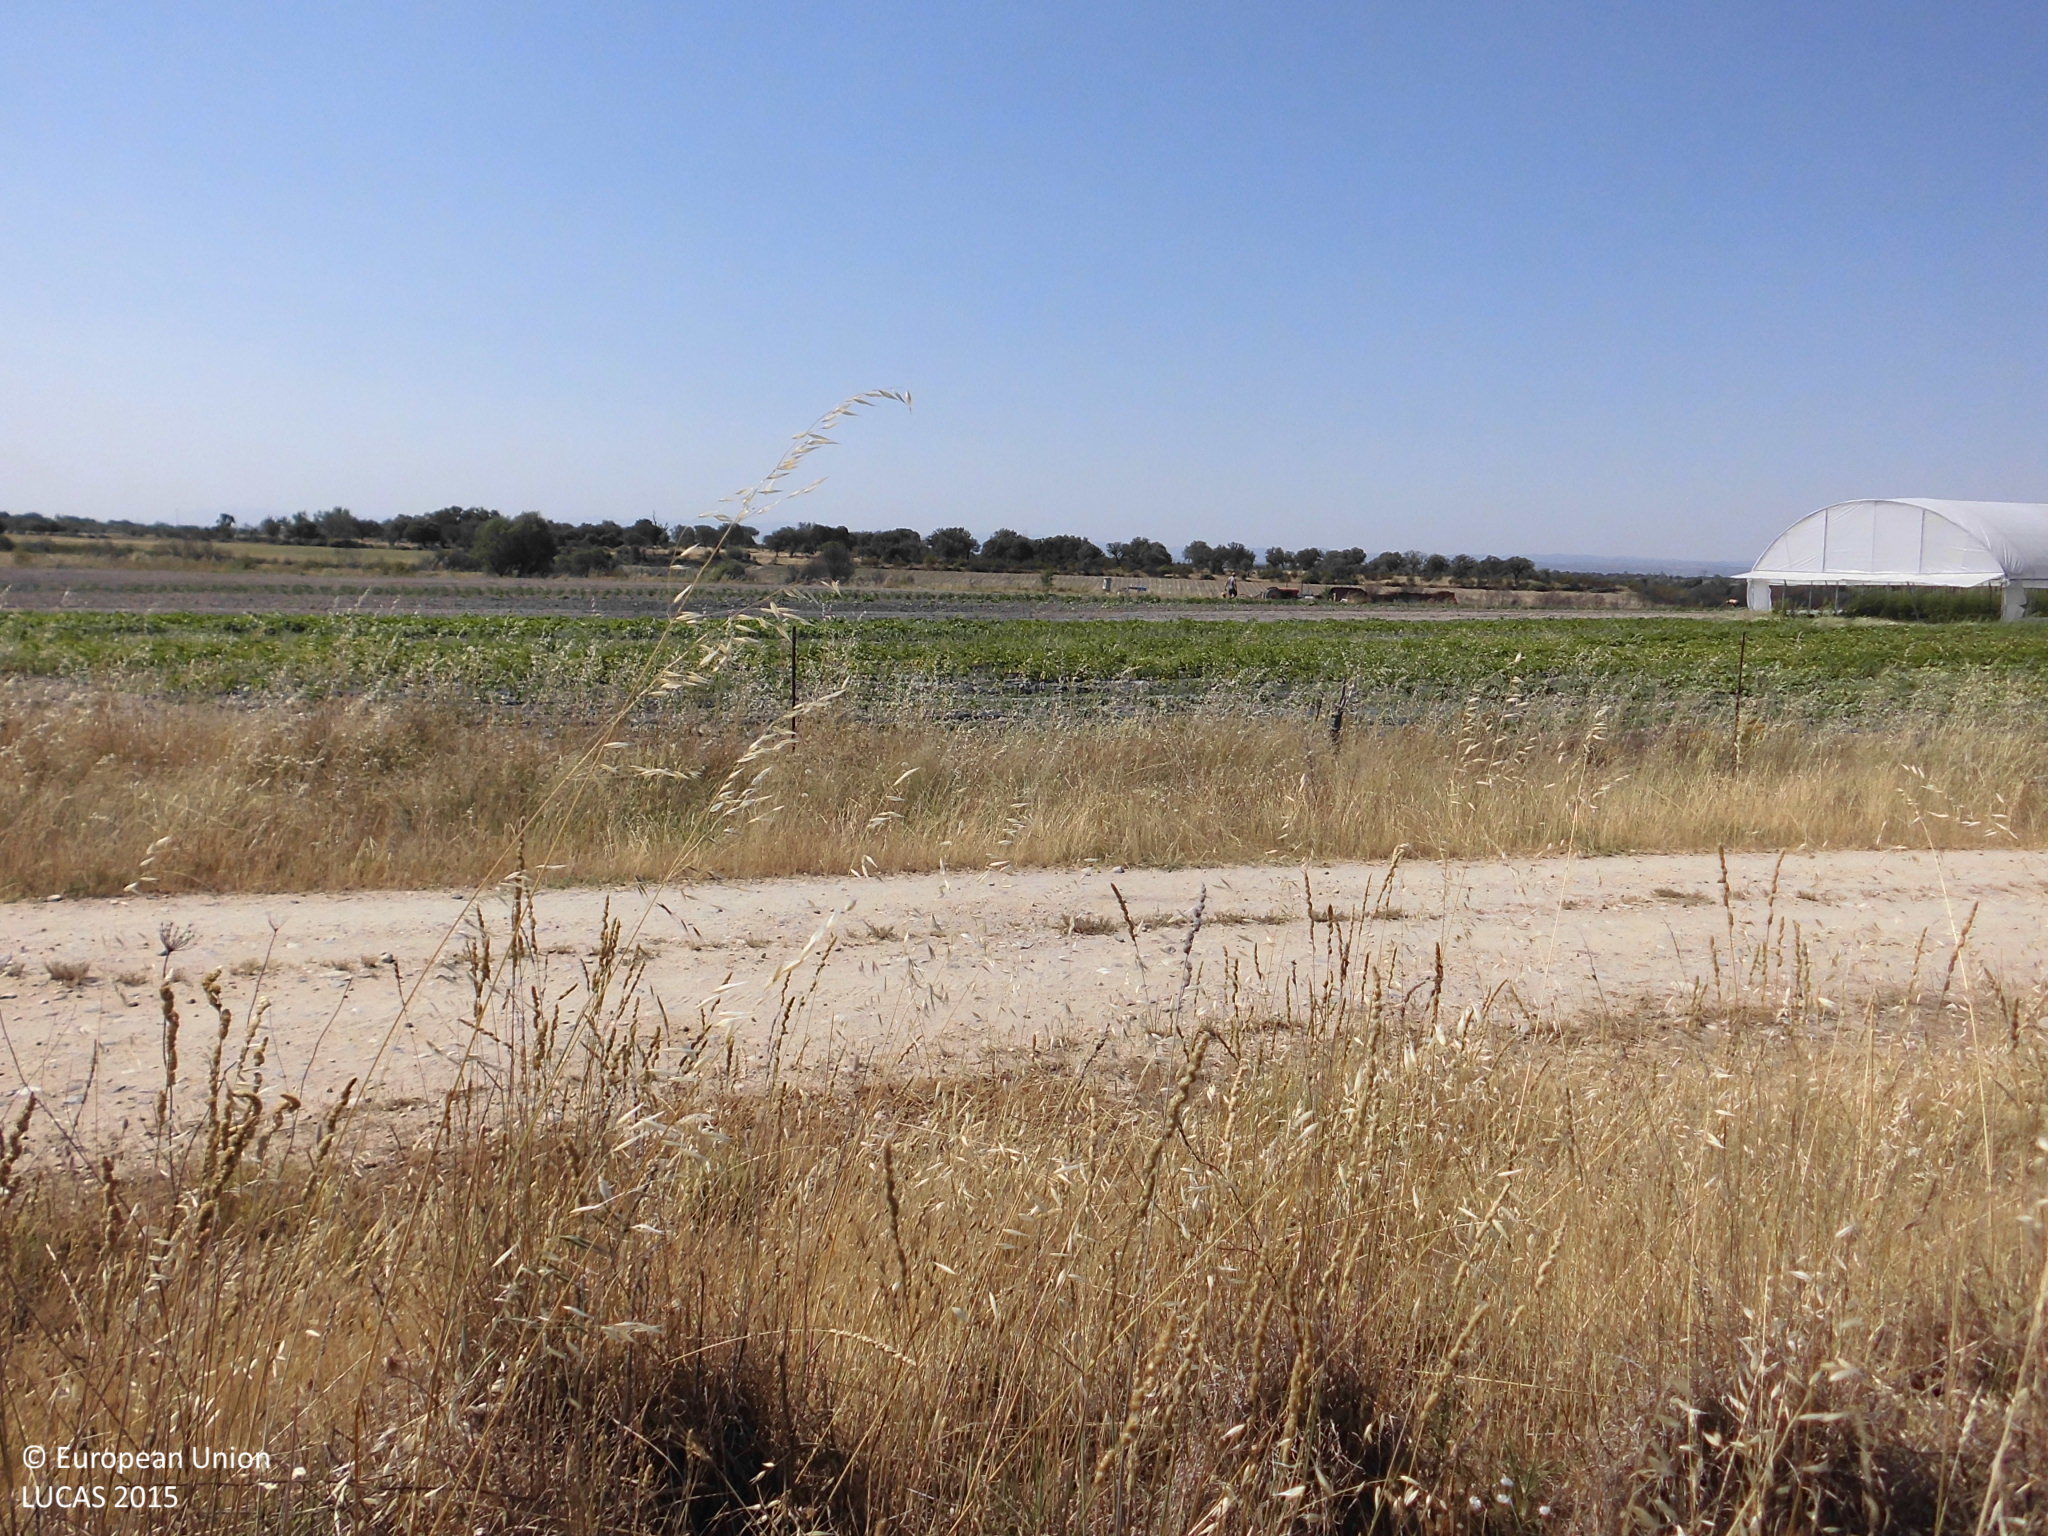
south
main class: Grassland
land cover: Grassland with sparse tree/shrub cover
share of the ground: 25 - 50 %
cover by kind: herbaceous plants 60 %, consolidated bare surface 30 %, broadleaved forest trees 5 %, shrubs 5 %
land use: Abandoned areas
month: June
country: ES
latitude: 40.0249
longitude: -5.4681
